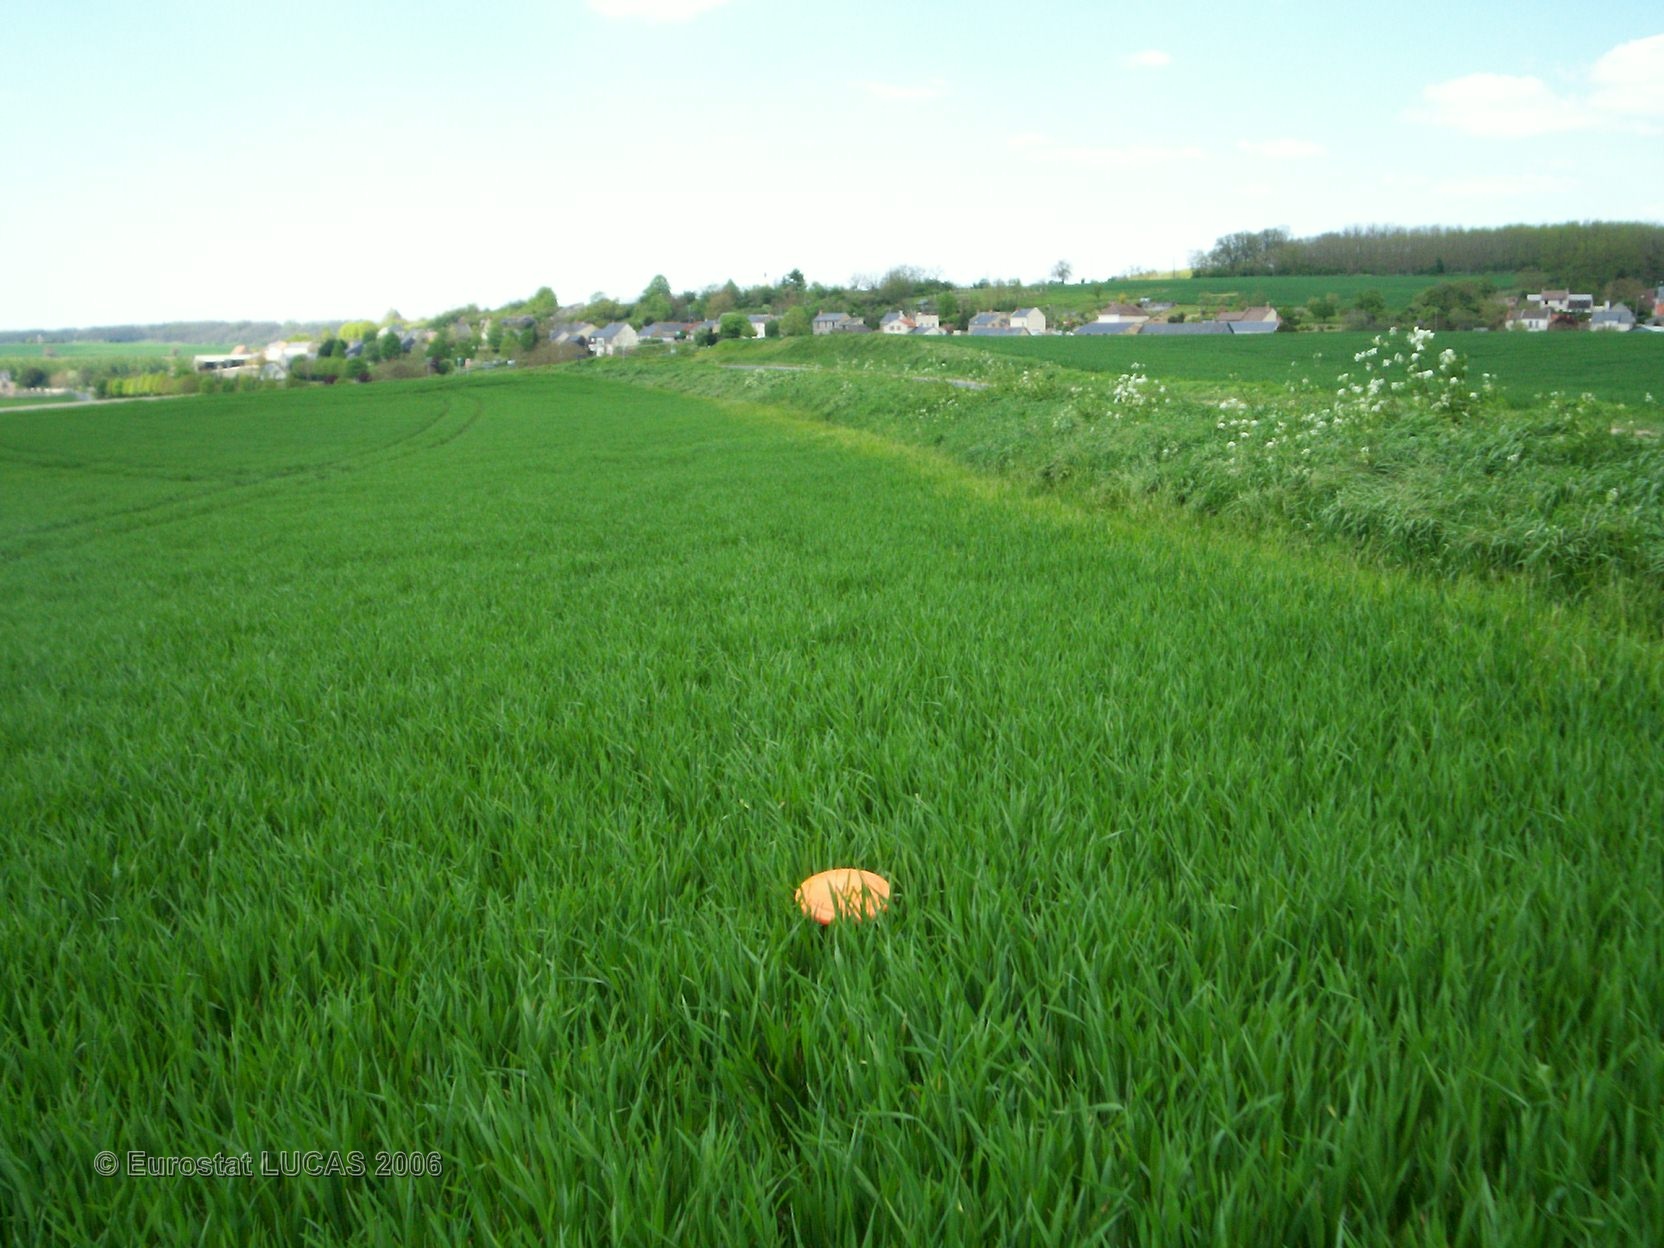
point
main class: Cropland
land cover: Common wheat
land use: Agriculture (excluding fallow land and kitchen gardens)
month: April
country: FR
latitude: 47.1340
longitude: 0.2080
